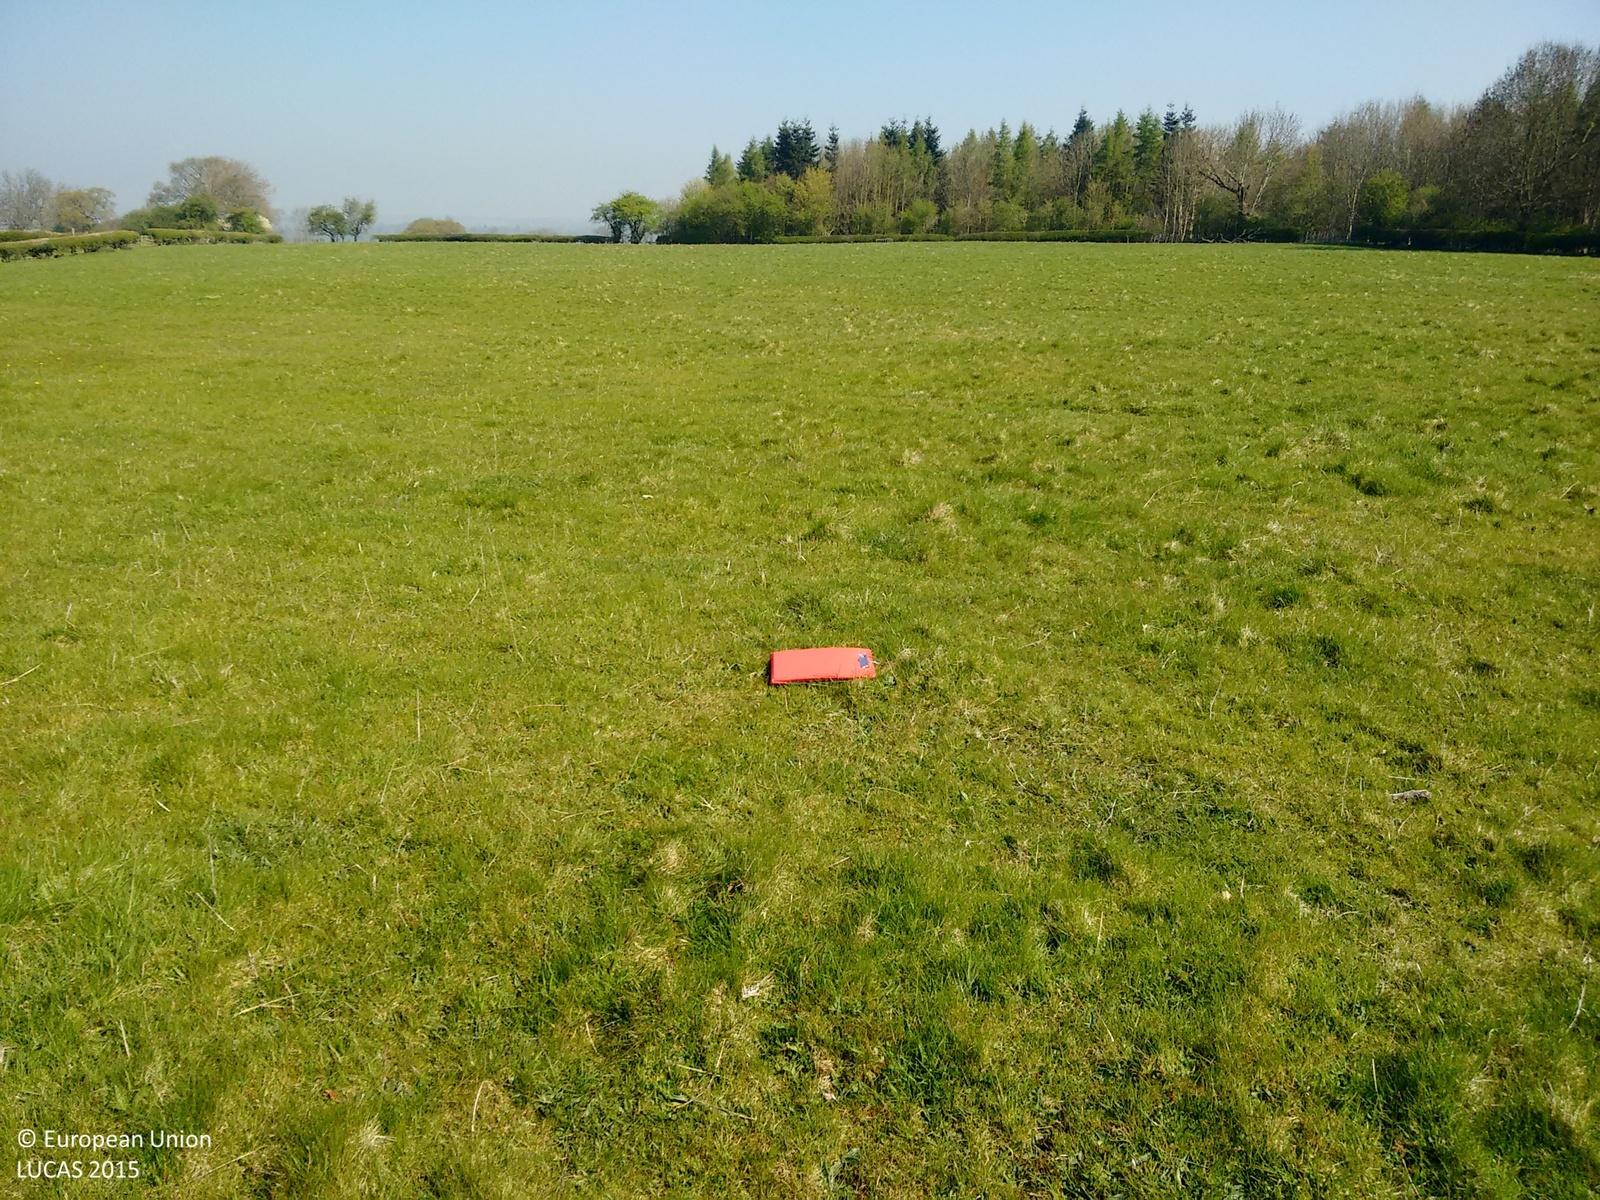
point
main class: Grassland
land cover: Grassland without tree/shrub cover
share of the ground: > 75 %
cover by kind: herbaceous plants 100 %
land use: Agriculture (excluding fallow land and kitchen gardens)
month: April
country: GB
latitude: 53.9023
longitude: -1.7265
